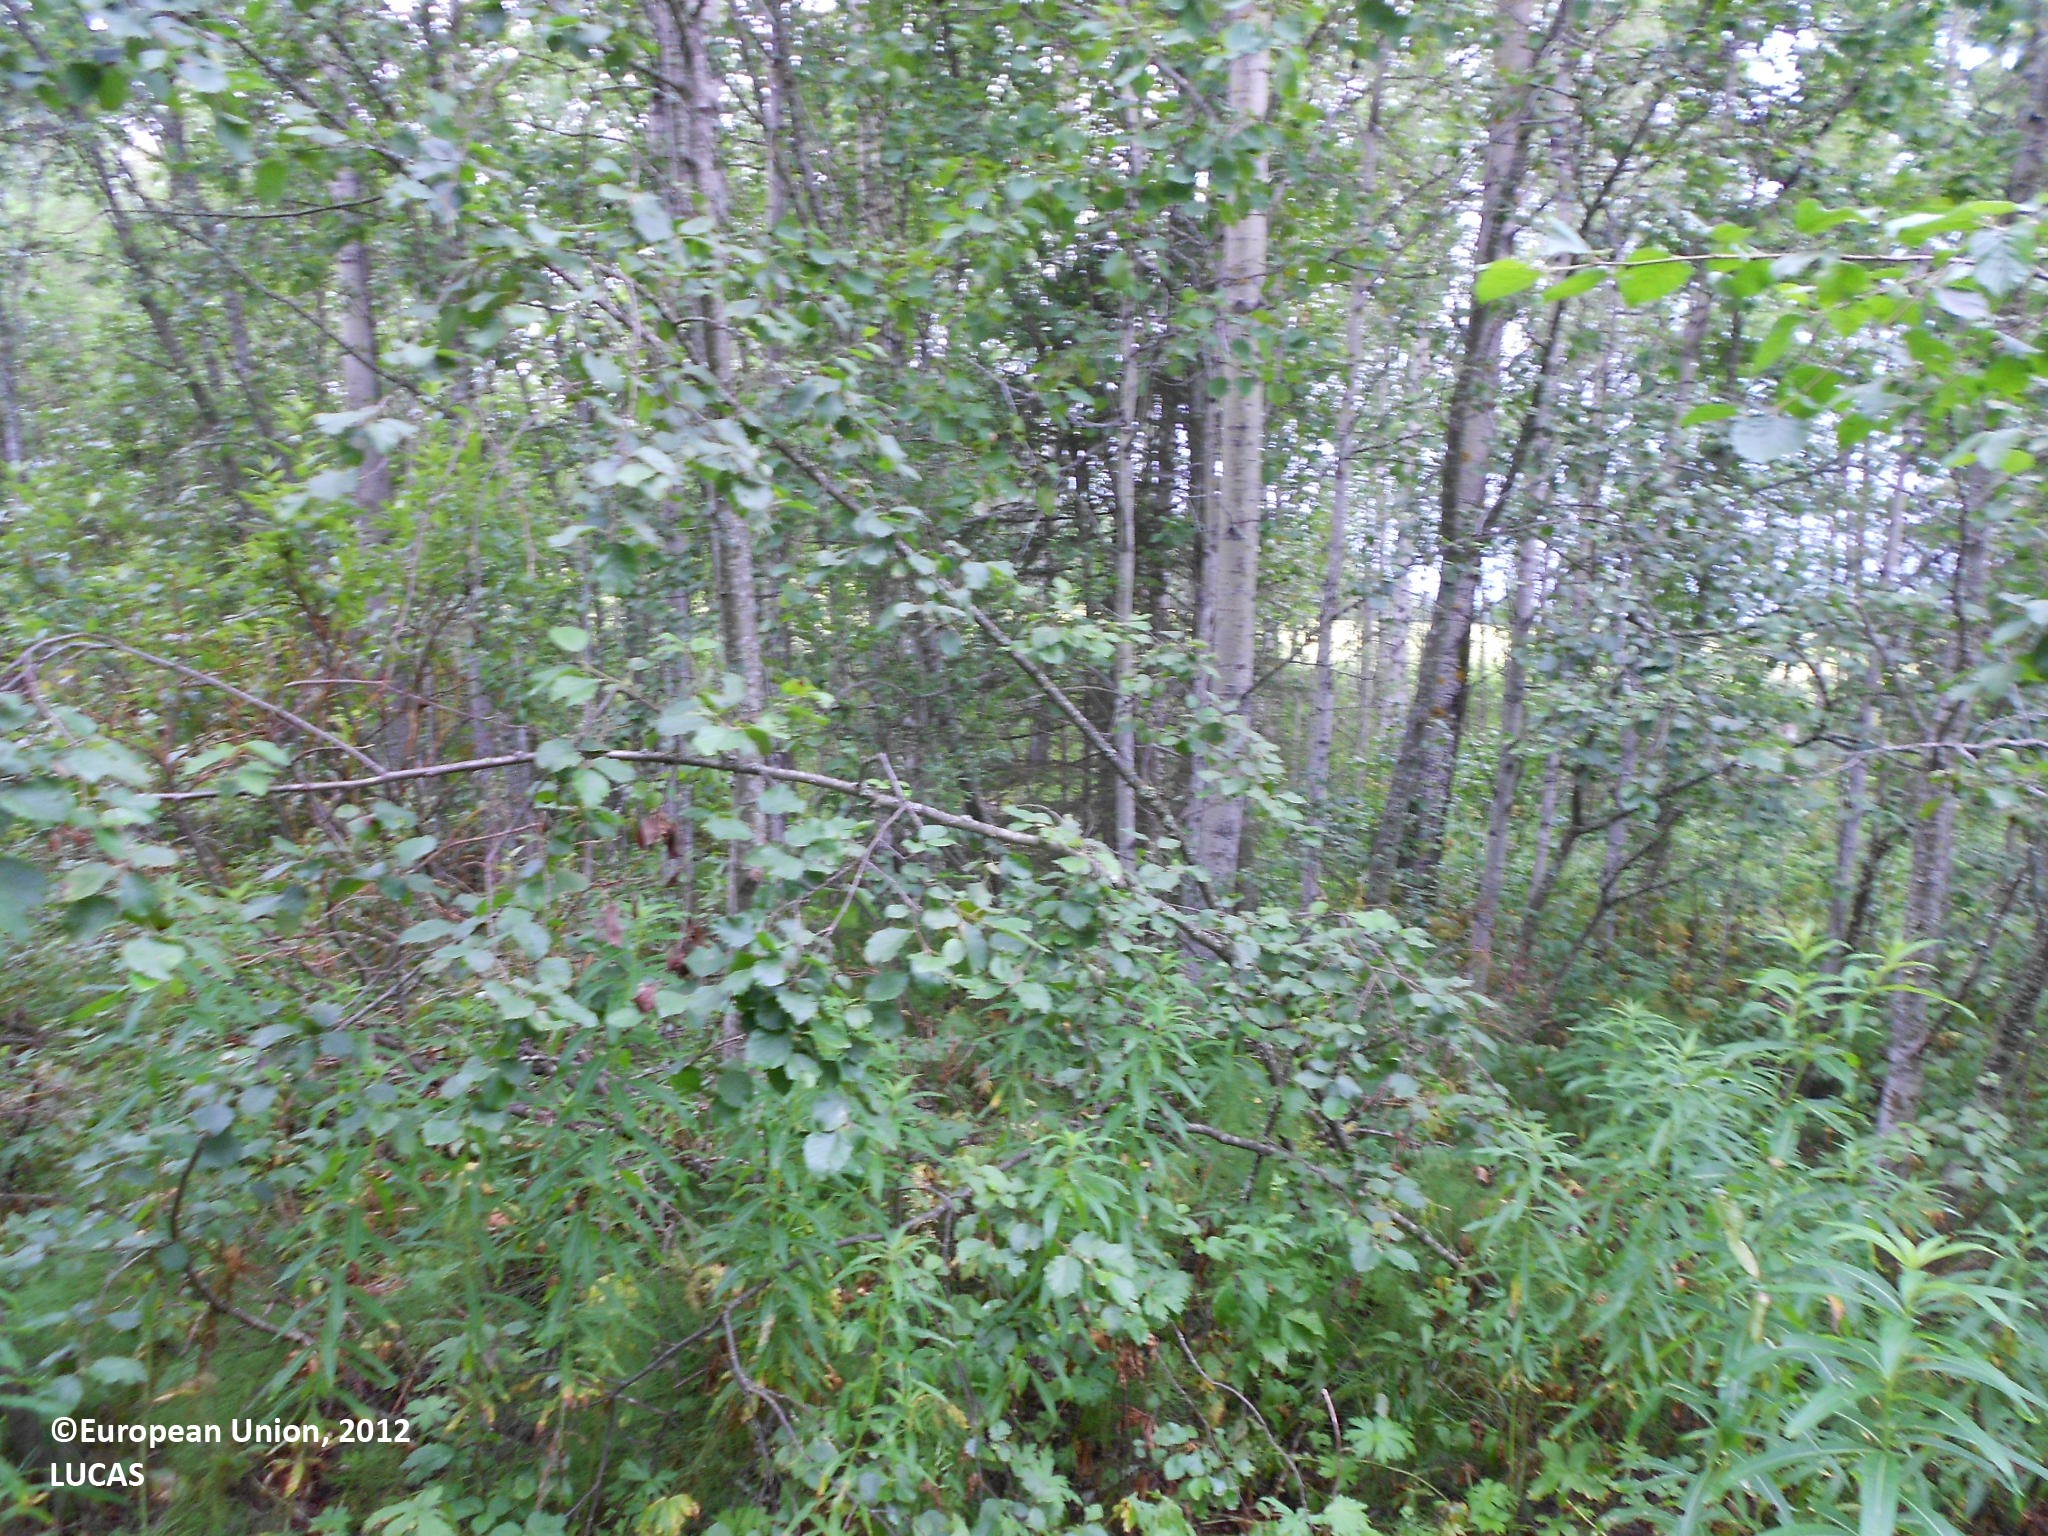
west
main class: Woodland
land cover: Broadleaved woodland
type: boreal forest
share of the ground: 50 - 75 %
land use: Forestry
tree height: > 5 m
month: August
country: FI
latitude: 63.5050
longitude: 28.9092
